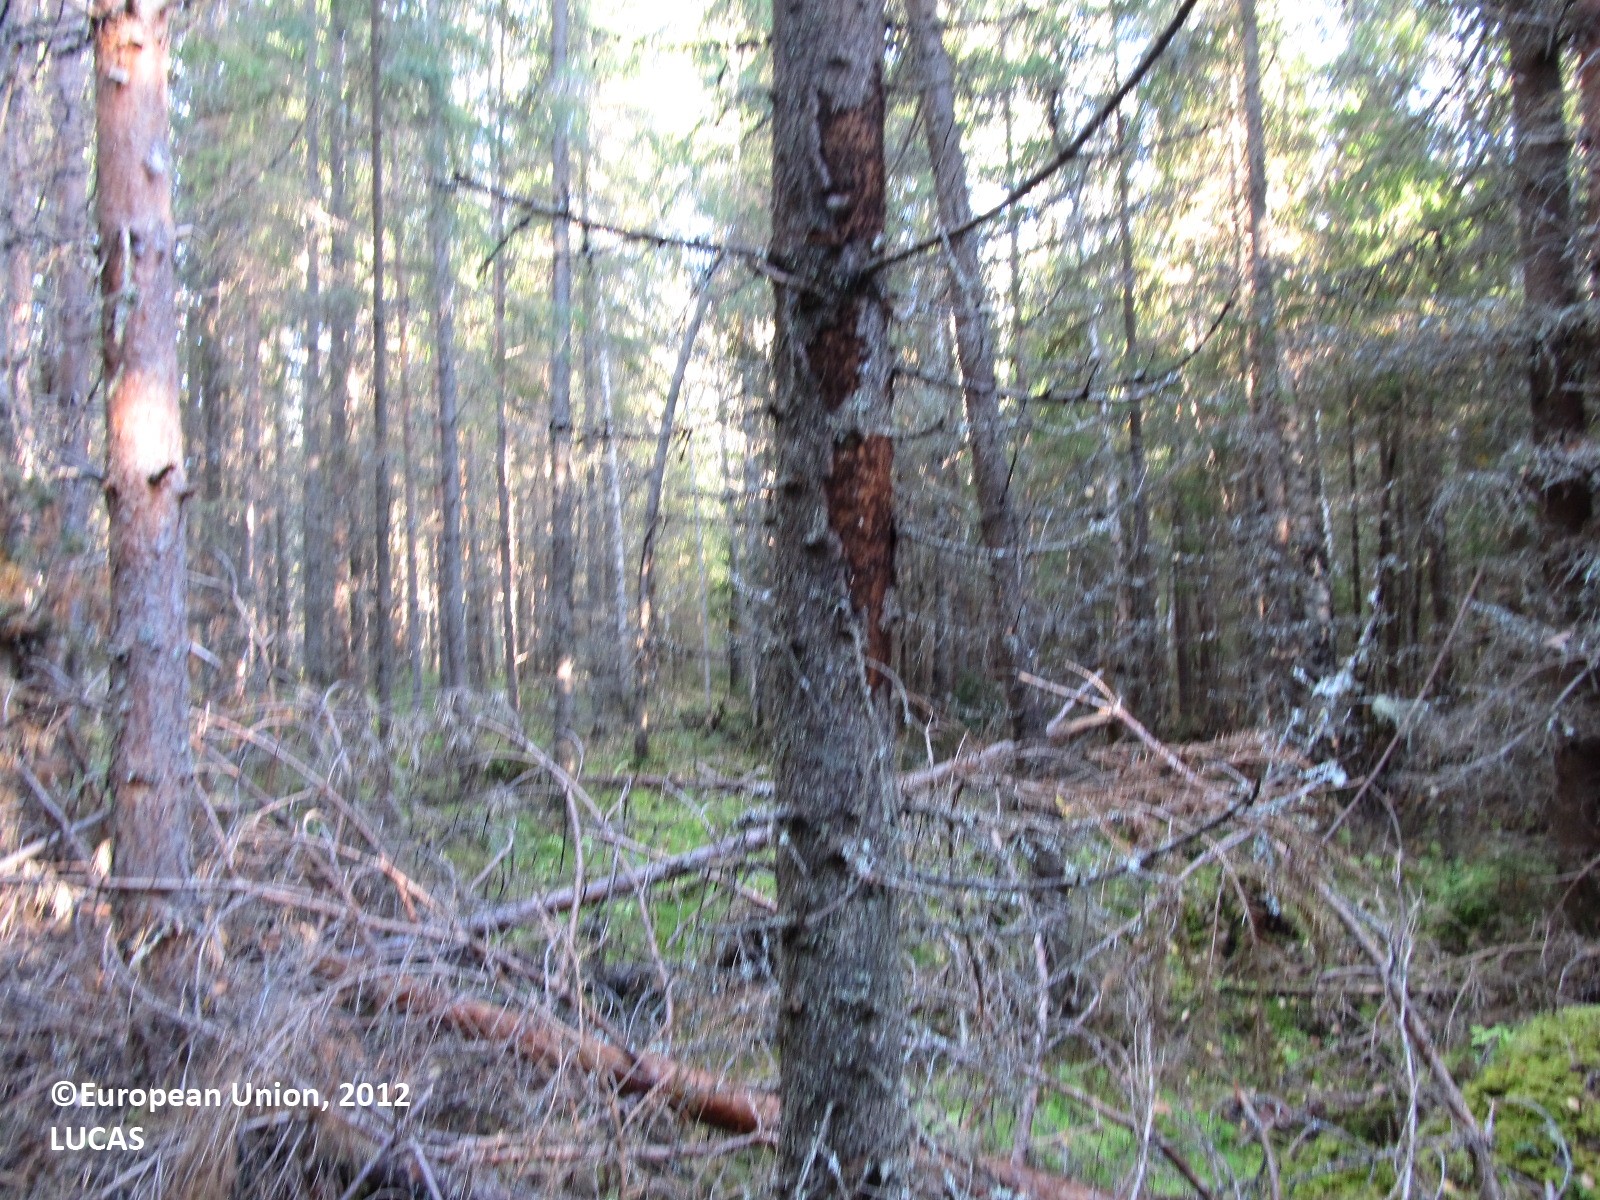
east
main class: Woodland
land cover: Pine dominated coniferous woodland
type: boreal forest
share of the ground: 50 - 75 %
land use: Forestry
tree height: > 5 m
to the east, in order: Pine dominated coniferous woodland; Ditches and canals; Pine dominated coniferous woodland; Ditches and canals; Spruce dominated mixed woodland
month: September
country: FI
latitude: 62.3973
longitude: 28.3635
